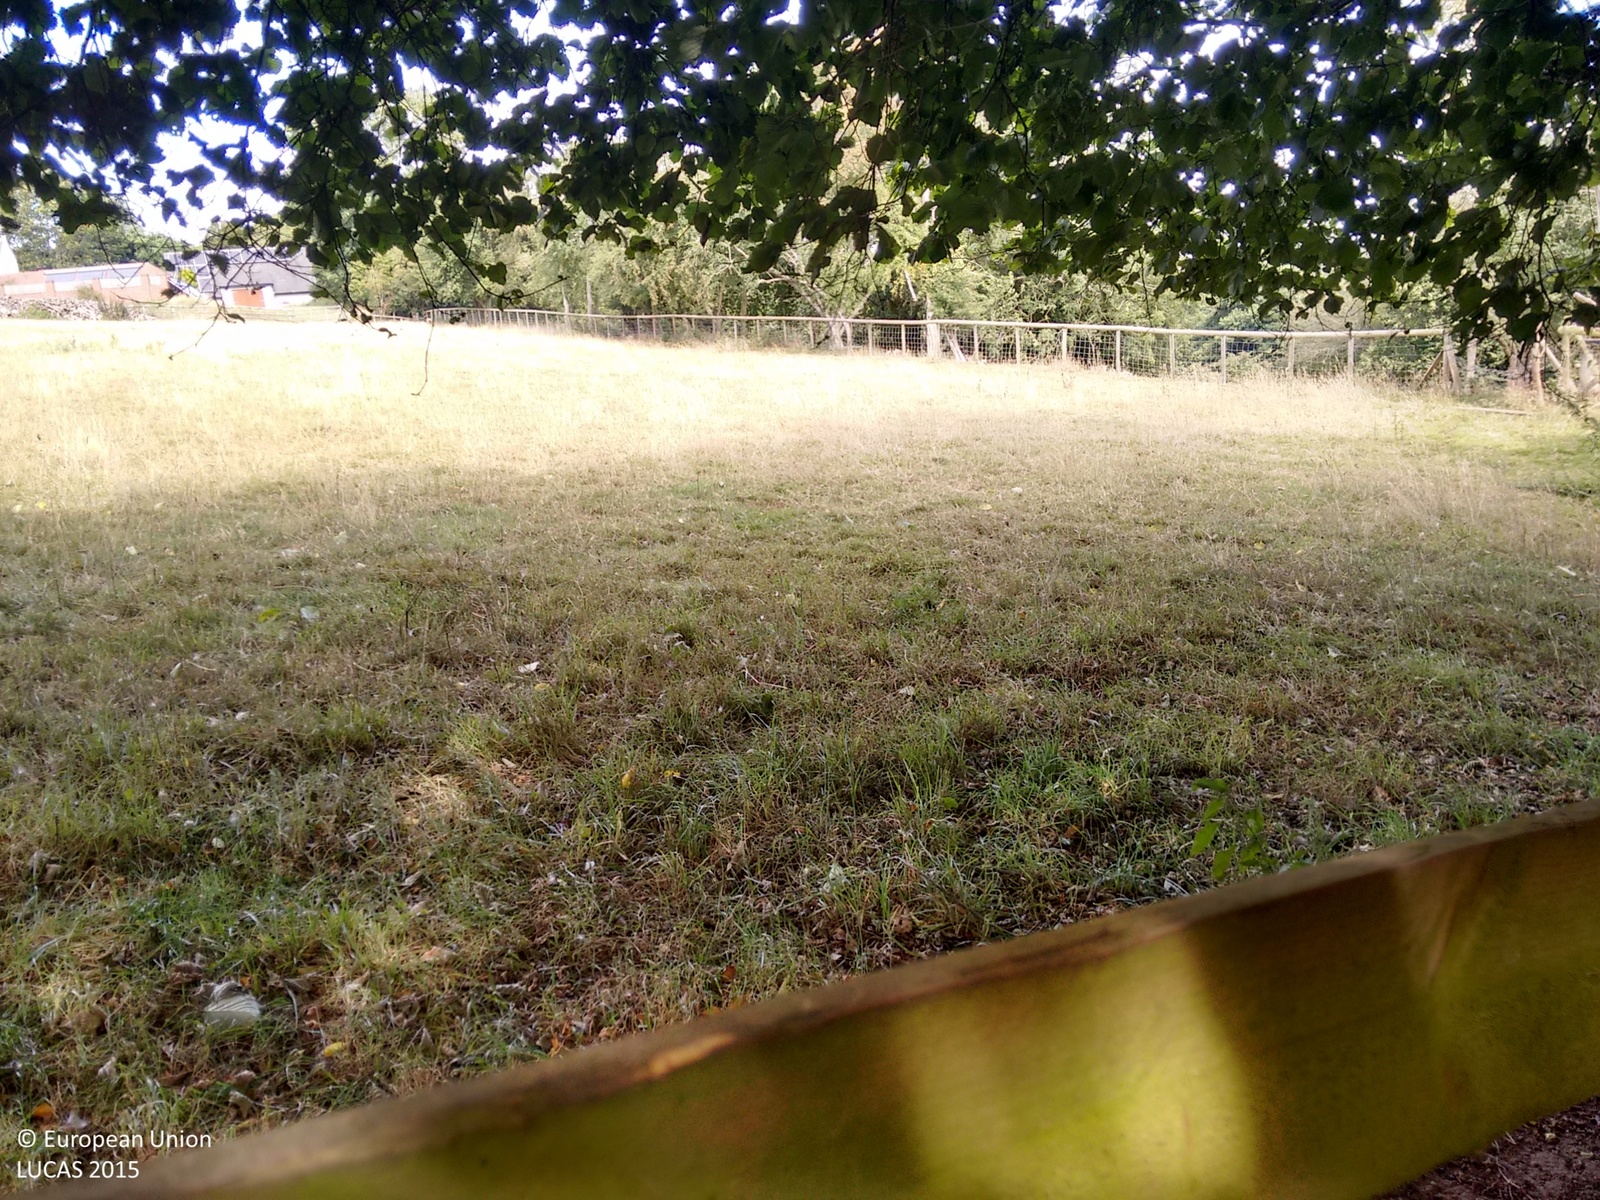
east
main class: Grassland
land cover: Grassland without tree/shrub cover
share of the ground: > 75 %
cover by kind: herbaceous plants 100 %
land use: Agriculture (excluding fallow land and kitchen gardens)
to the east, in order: Grassland without tree/shrub cover; Fences; Single bushes/trees; Grassland without tree/shrub cover; Fences; Broadleaved woodland; Grassland without tree/shrub cover; Single bushes/trees; Electric lines; Grassland without tree/shrub cover; Broadleaved woodland; Rivers and streams; Broadleaved woodland; Grass margins; Paved roads, cycling and walking lanes; Grass margins; Electric lines; Managed hedges; Fences; Grassland without tree/shrub cover
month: August
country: GB
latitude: 51.8924
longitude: -2.6972
